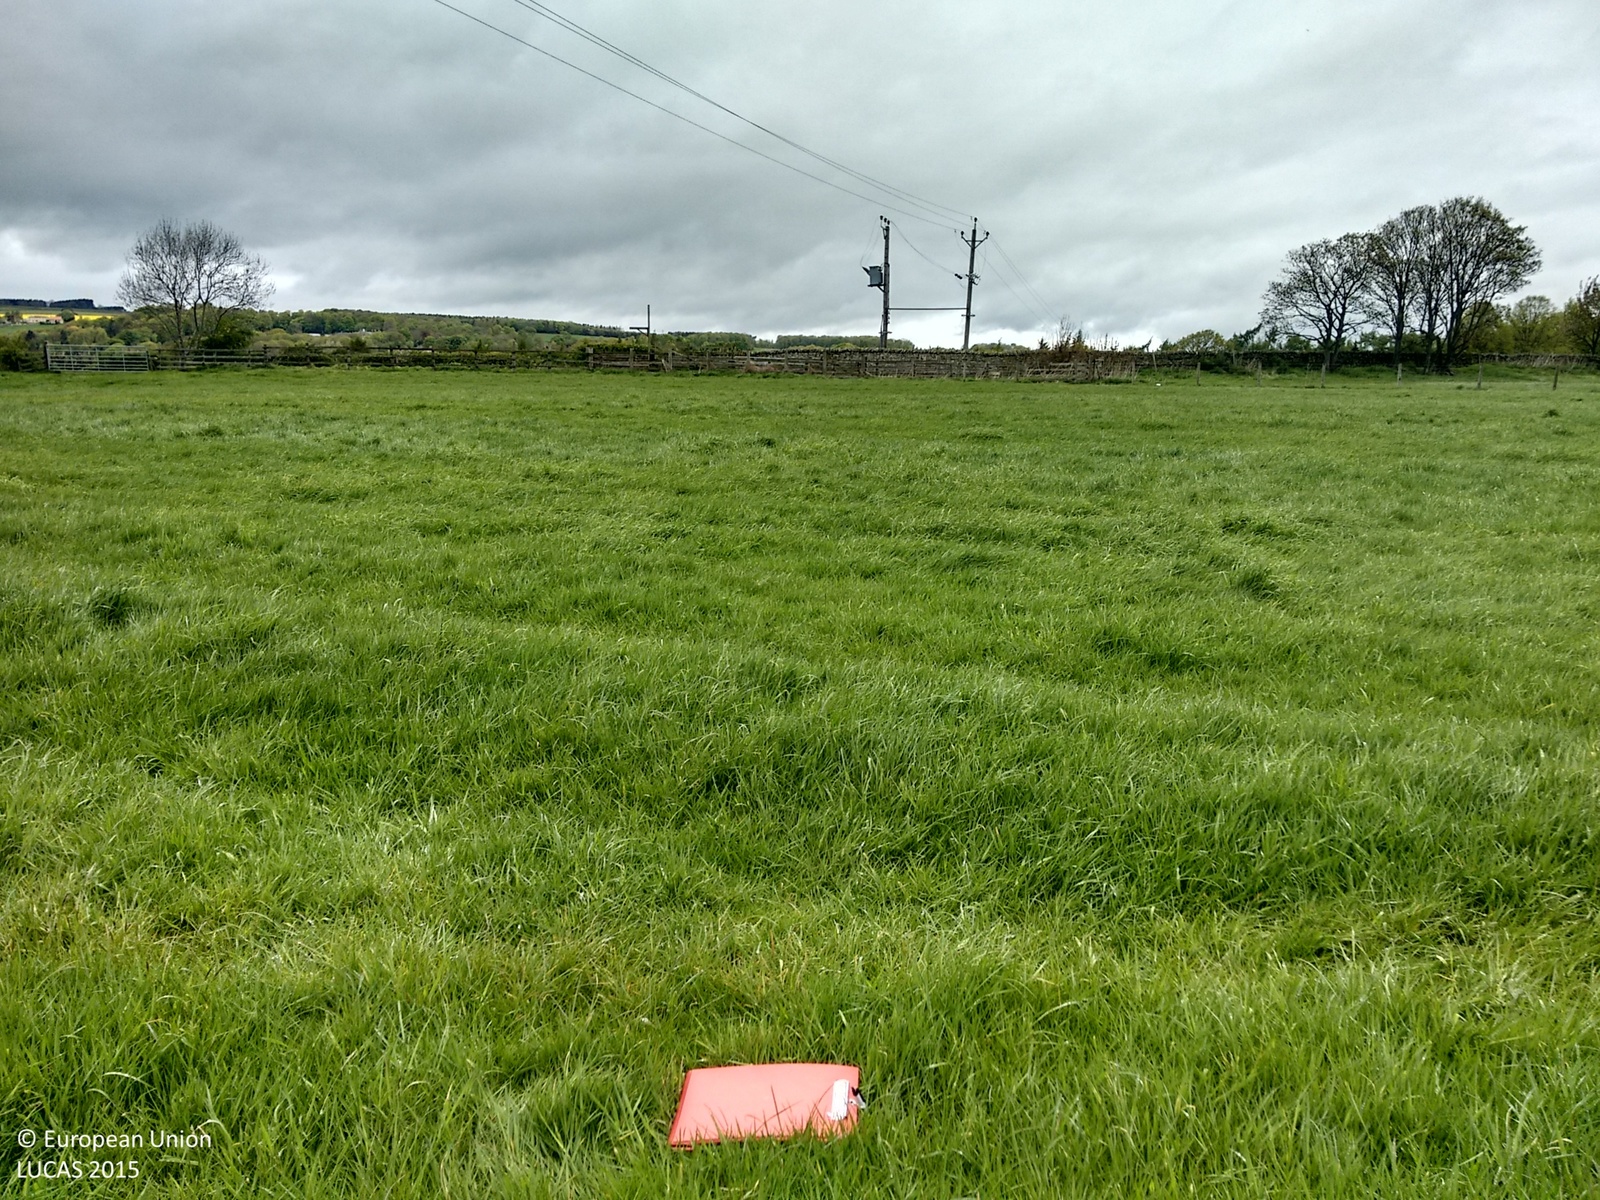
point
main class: Grassland
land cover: Grassland without tree/shrub cover
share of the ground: > 75 %
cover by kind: herbaceous plants 100 %
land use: Agriculture (excluding fallow land and kitchen gardens)
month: May
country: GB
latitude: 54.9844
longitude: -2.0093
